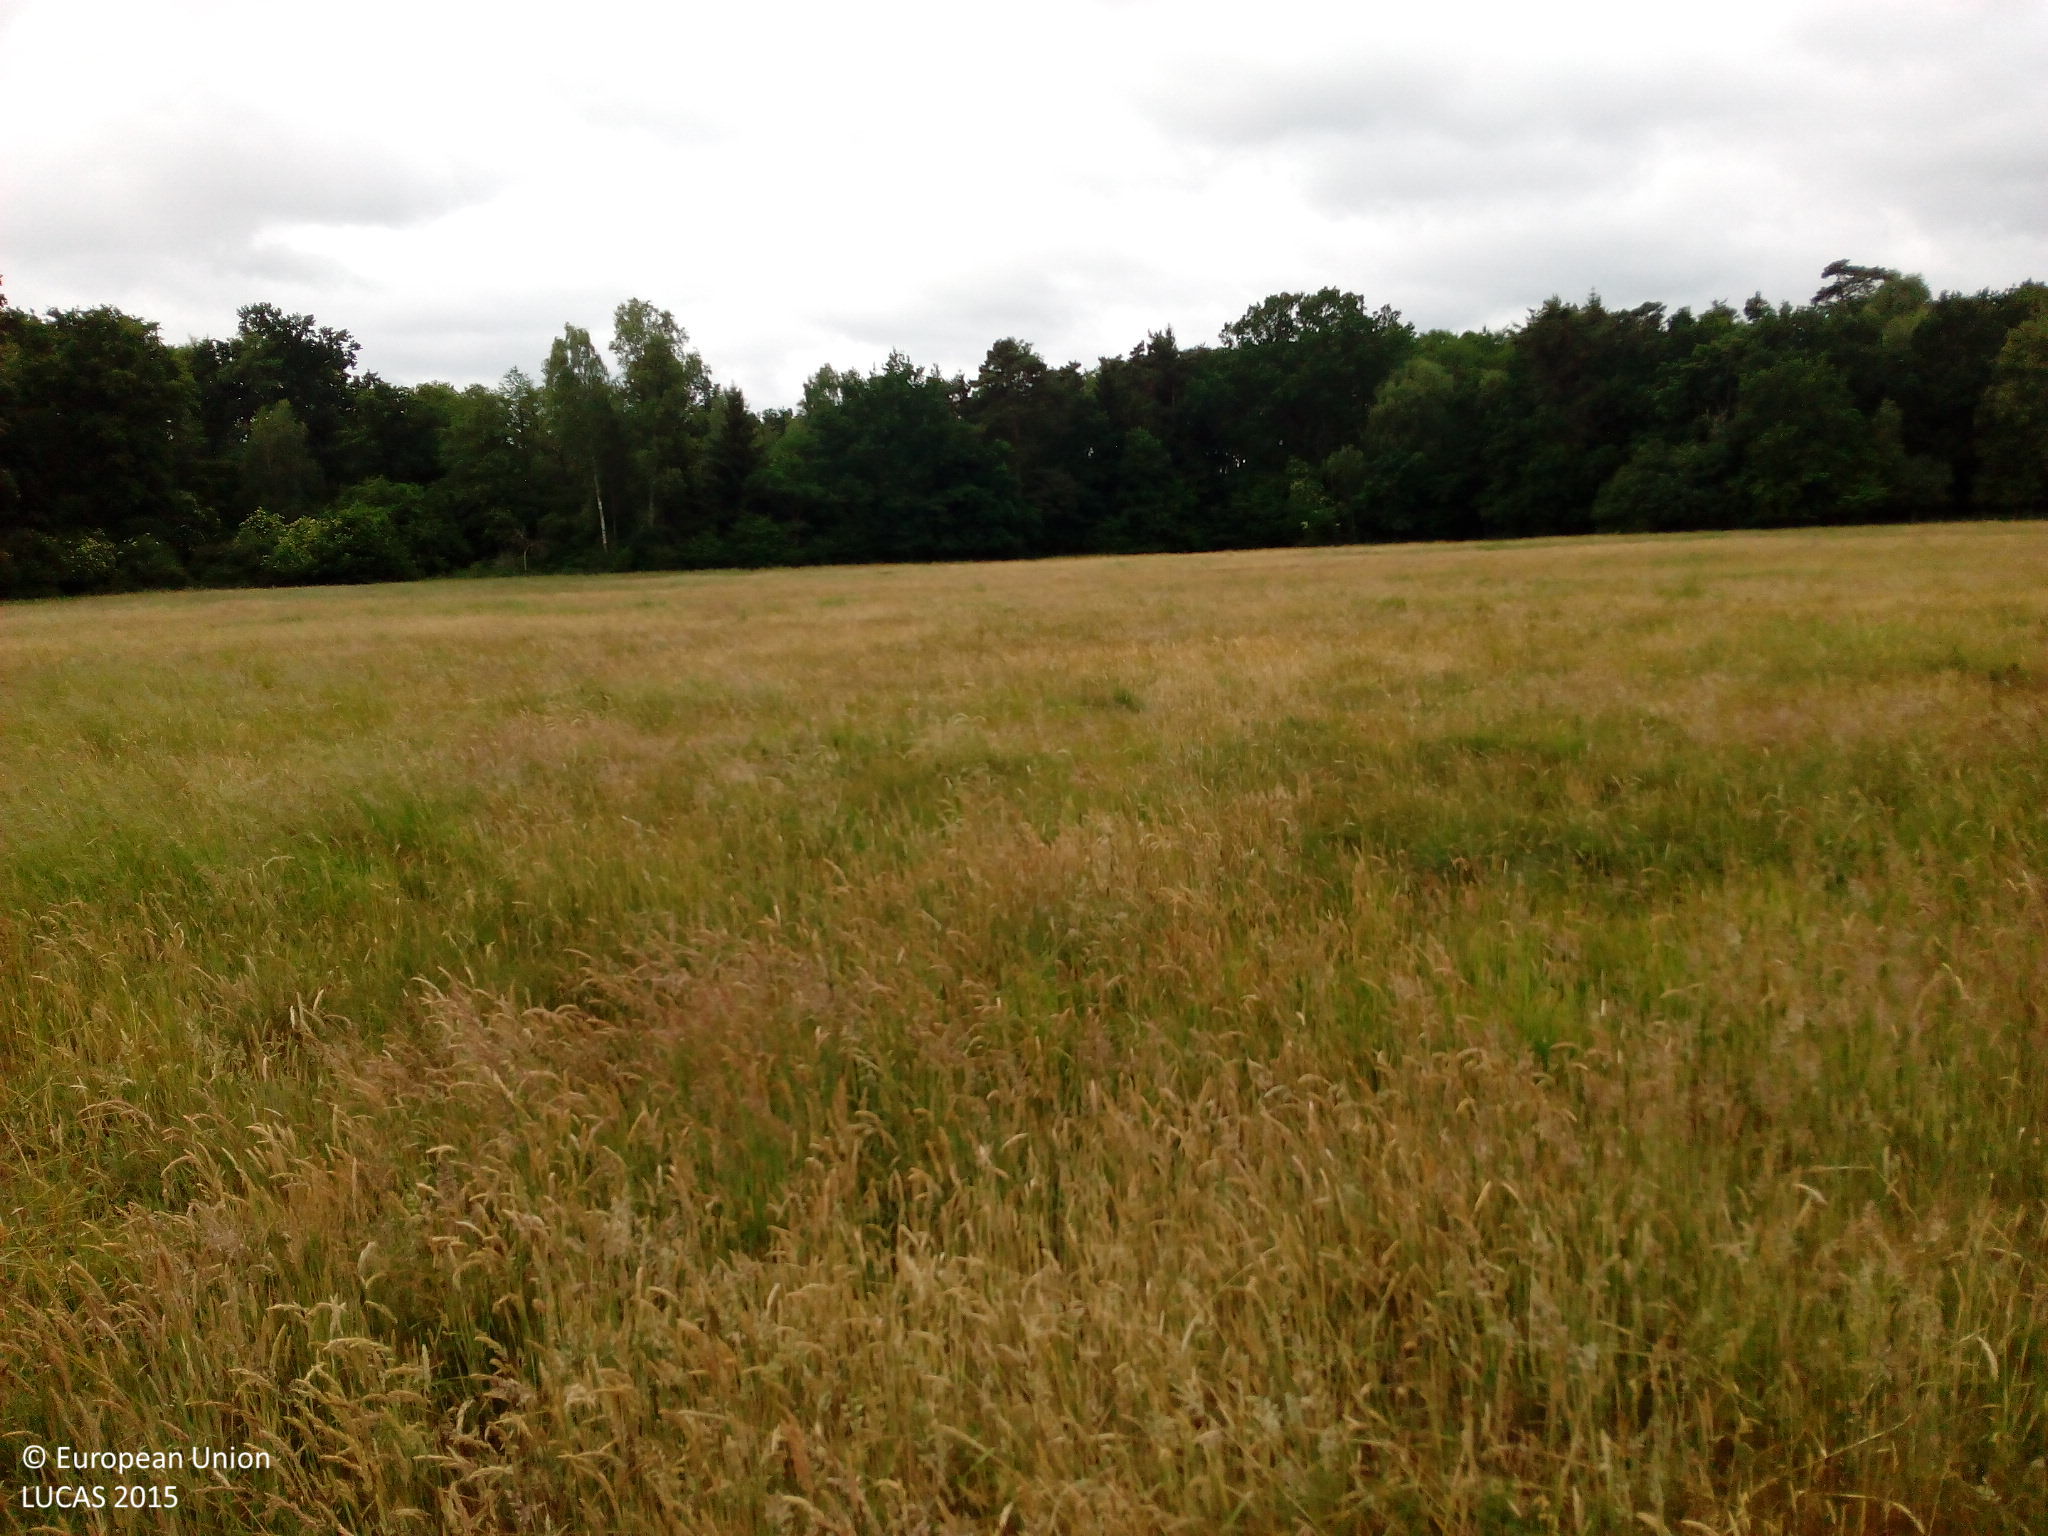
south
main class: Grassland
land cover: Spontaneously vegetated surfaces
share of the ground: > 75 %
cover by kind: herbaceous plants 100 %
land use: Semi-natural and natural areas not in use
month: June
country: DE
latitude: 52.6043
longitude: 12.4359
